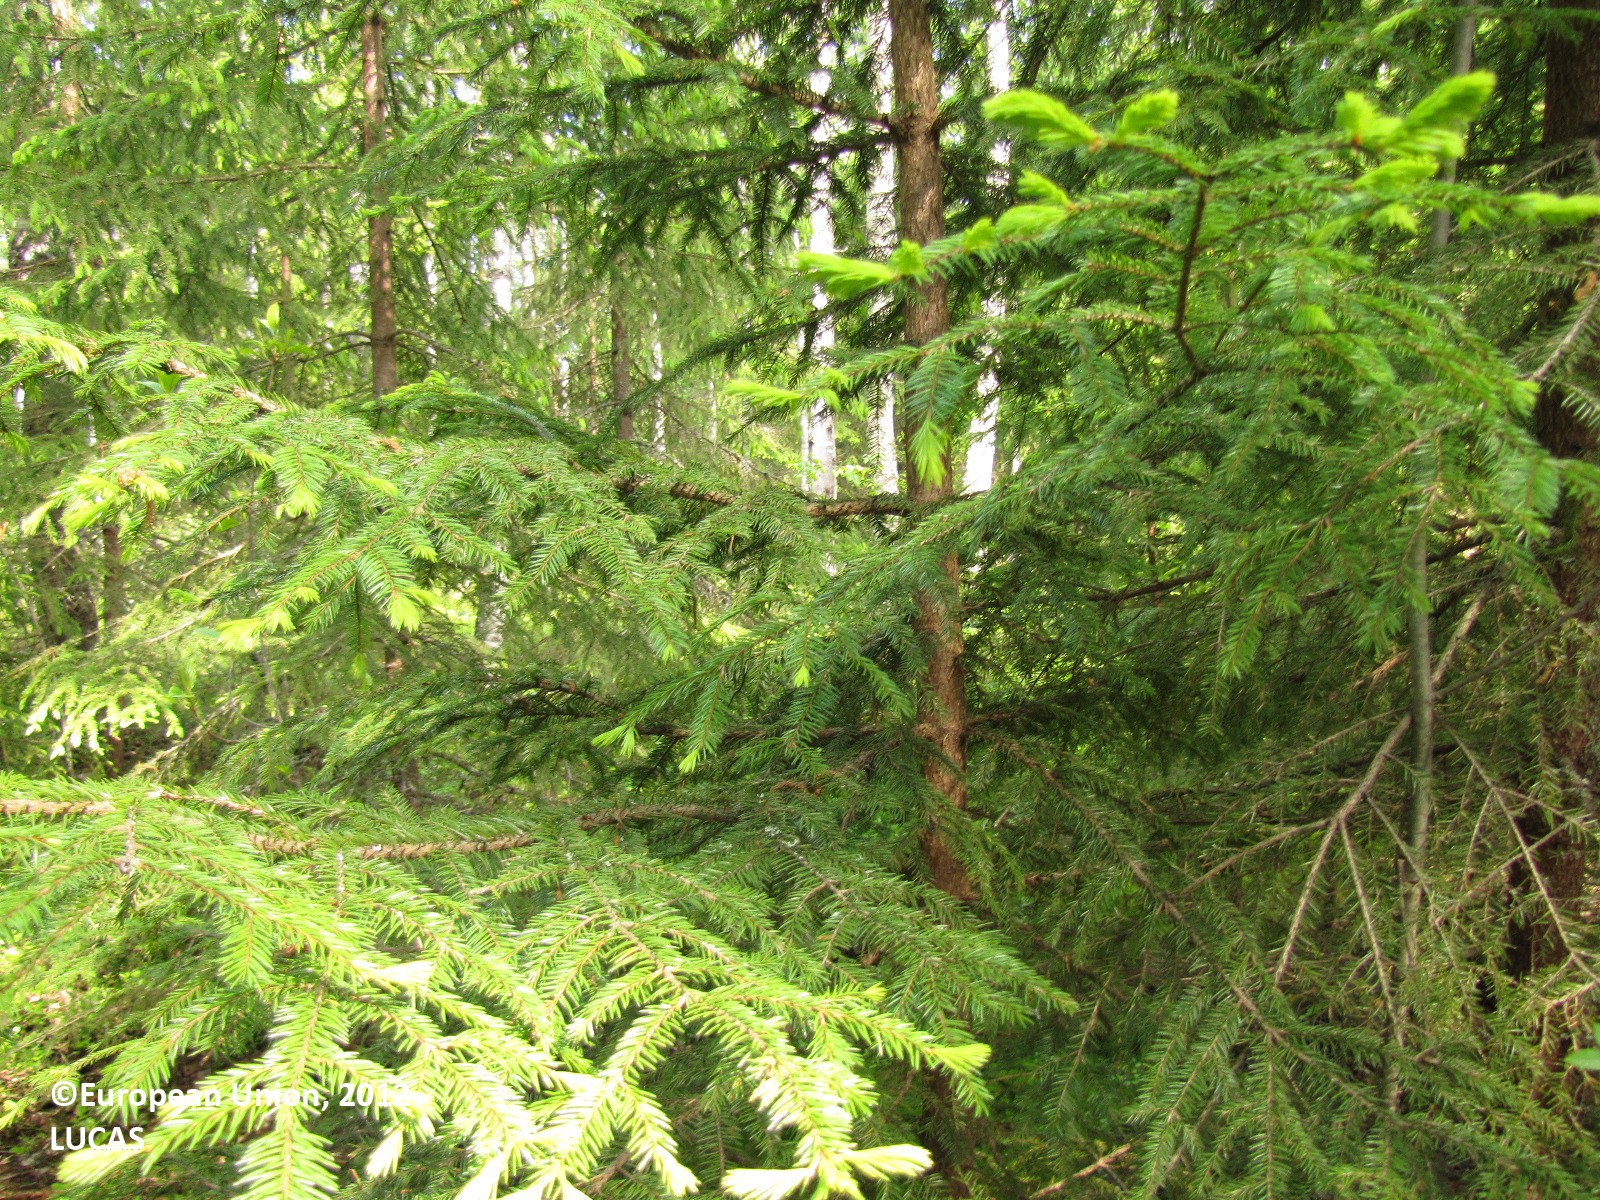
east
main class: Woodland
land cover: Other mixed woodland
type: boreal forest
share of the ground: > 75 %
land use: Forestry
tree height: > 5 m
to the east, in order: Other mixed woodland; Ditches and canals; Pine dominated coniferous woodland; Electric lines; Groves; Grass margins; Ditches and canals; Paved roads, cycling and walking lanes; Grassland without tree/shrub cover; Ditches and canals; Broadleaved woodland
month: June
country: FI
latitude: 61.4566
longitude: 23.0355
